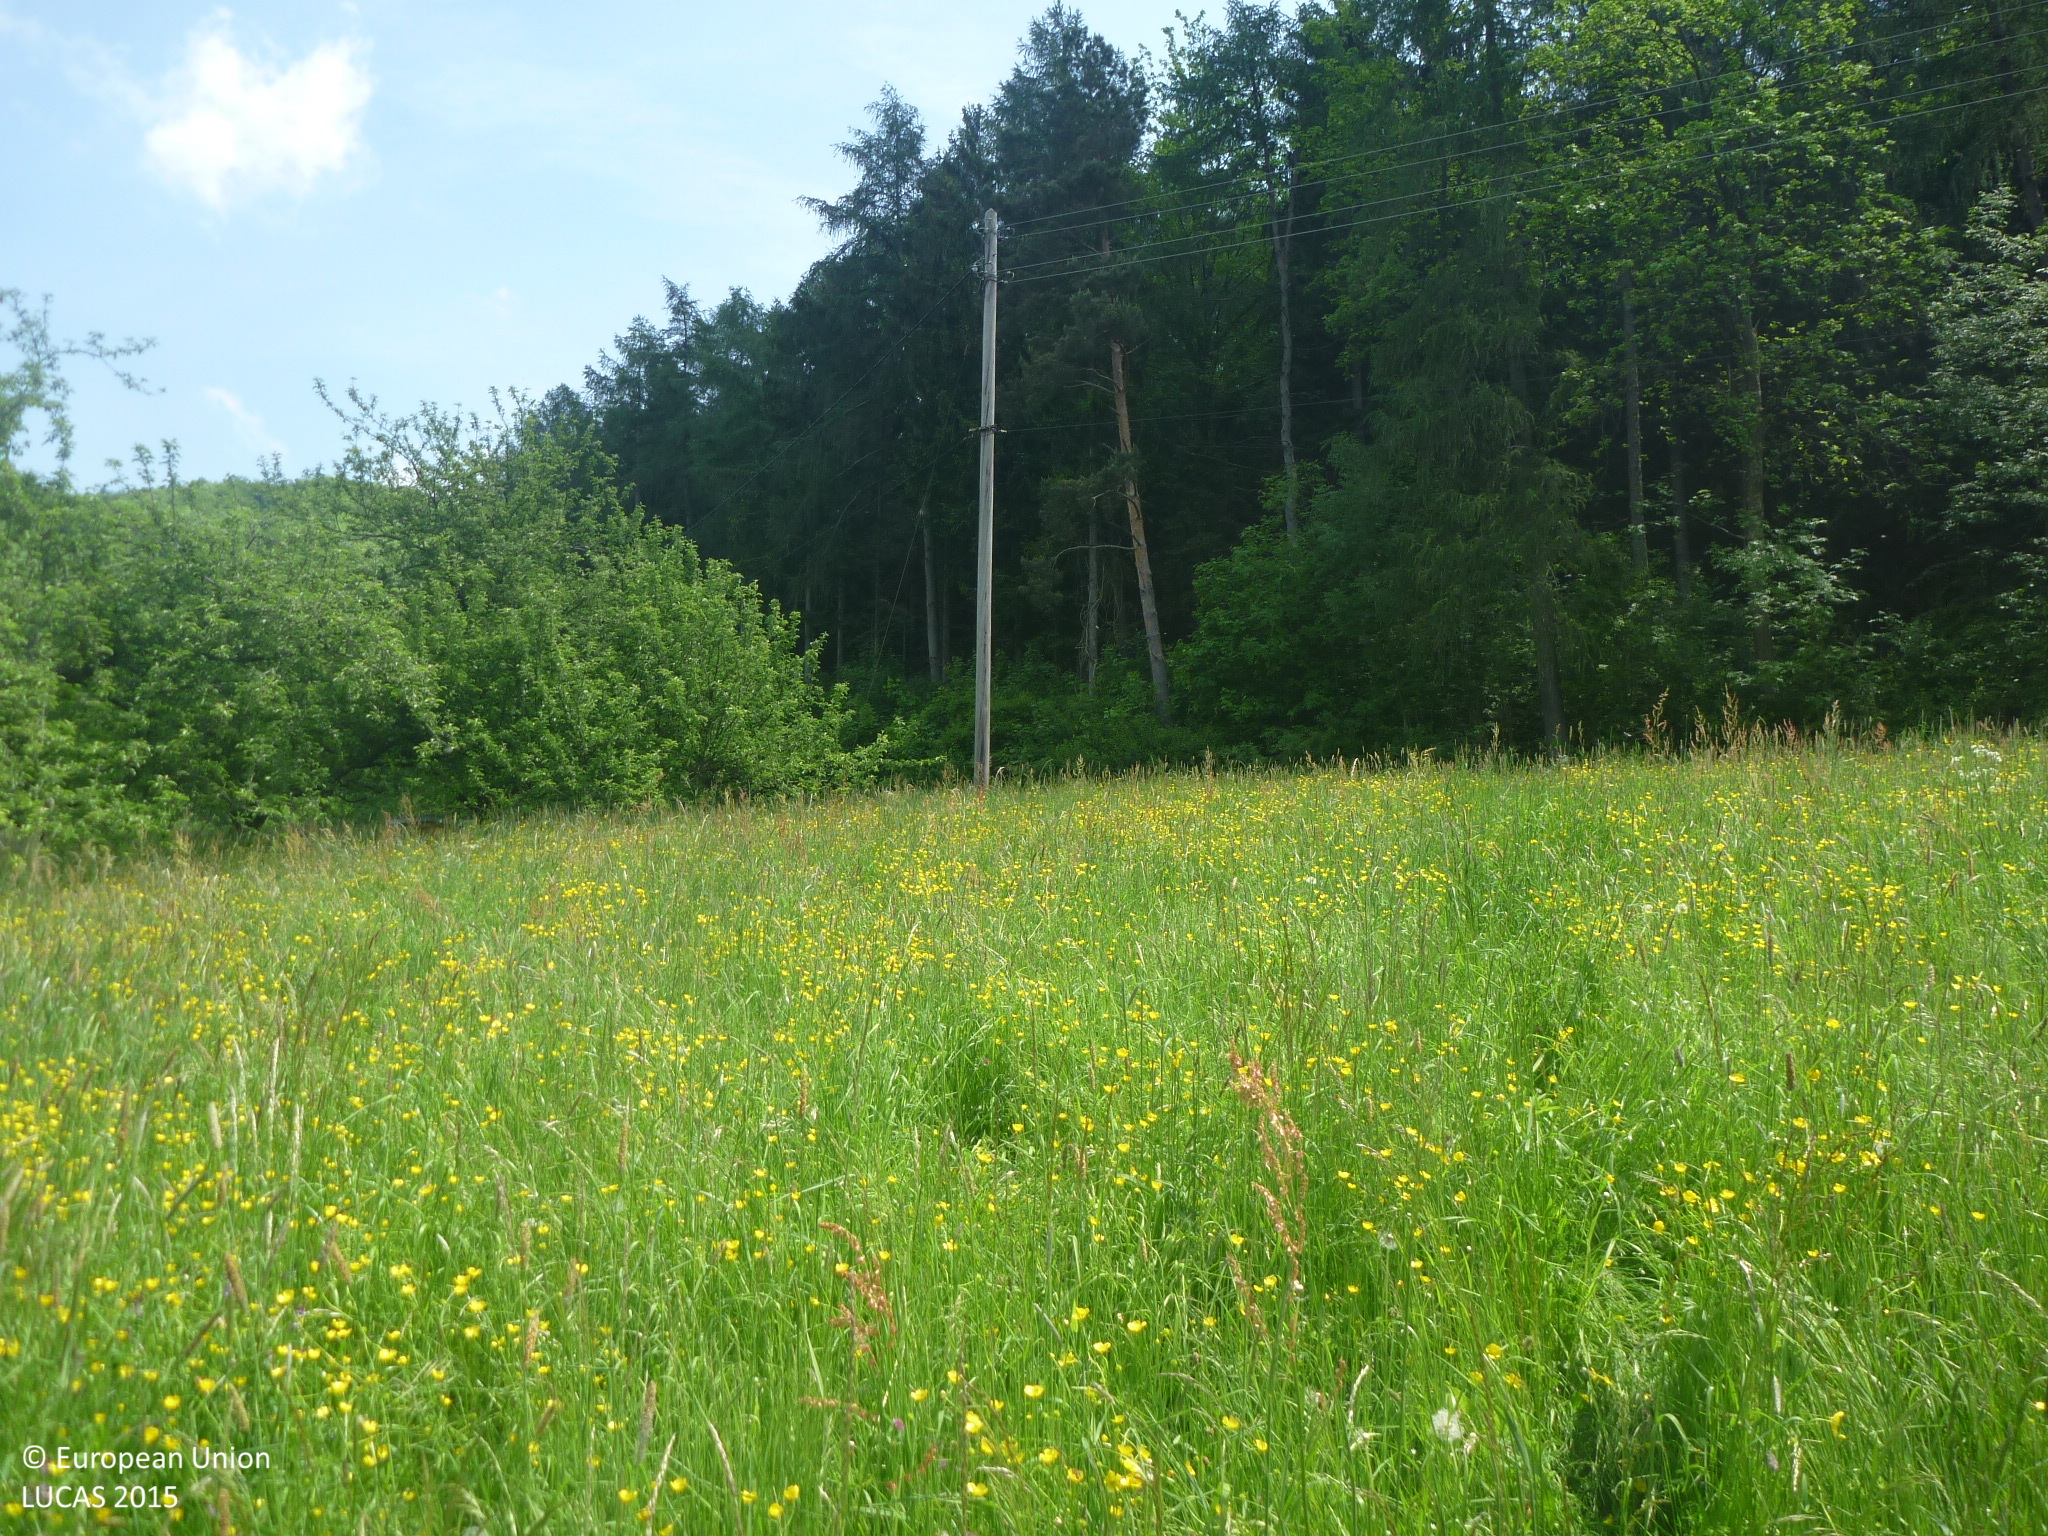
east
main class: Cropland
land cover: Apple fruit
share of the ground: 10 - 25 %
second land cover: Grassland without tree/shrub cover
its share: > 75 %
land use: Agriculture (excluding fallow land and kitchen gardens)
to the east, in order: Apple fruit; Grassland without tree/shrub cover; Electric lines; Grassland without tree/shrub cover; Tracks; Spruce dominated mixed woodland; Tracks; Spruce dominated mixed woodland; Tracks; Broadleaved woodland
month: May
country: DE
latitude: 48.4911
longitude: 9.2832
